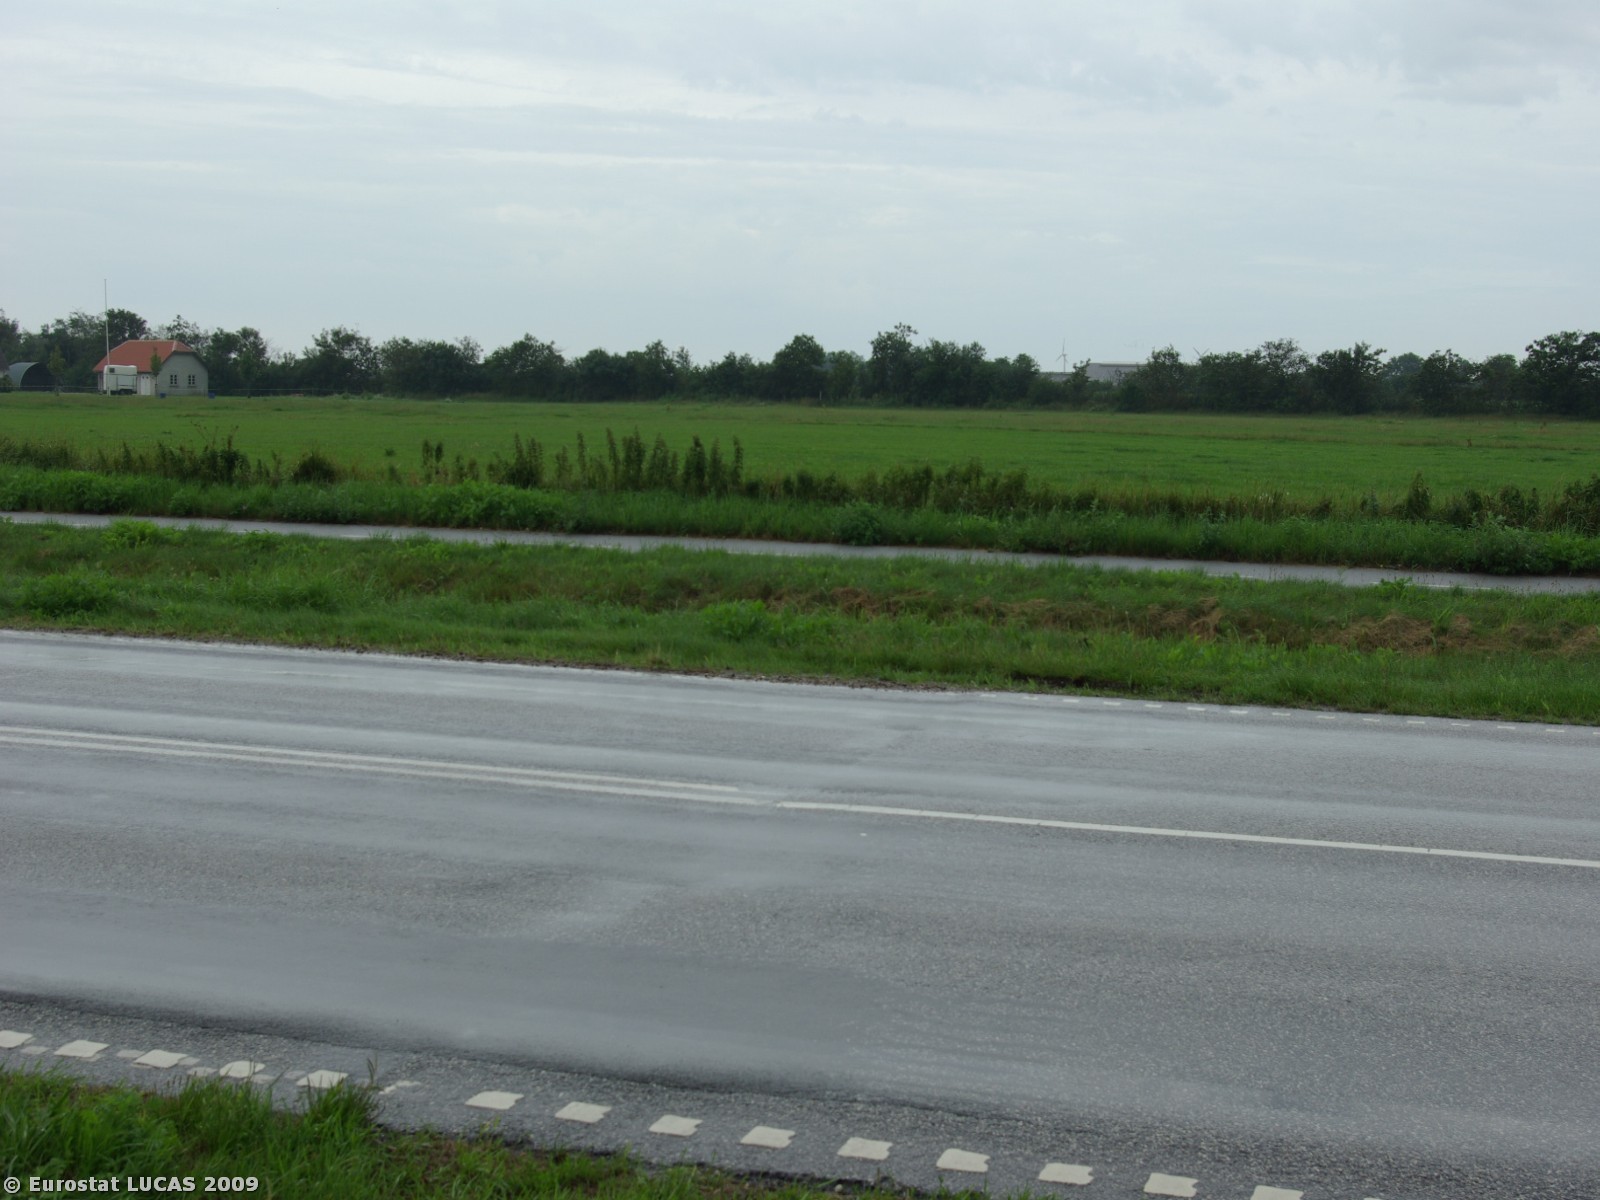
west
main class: Cropland
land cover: Maize
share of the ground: > 75 %
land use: Agriculture (excluding fallow land and kitchen gardens)
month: July
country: DK
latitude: 55.2287
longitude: 8.7275
